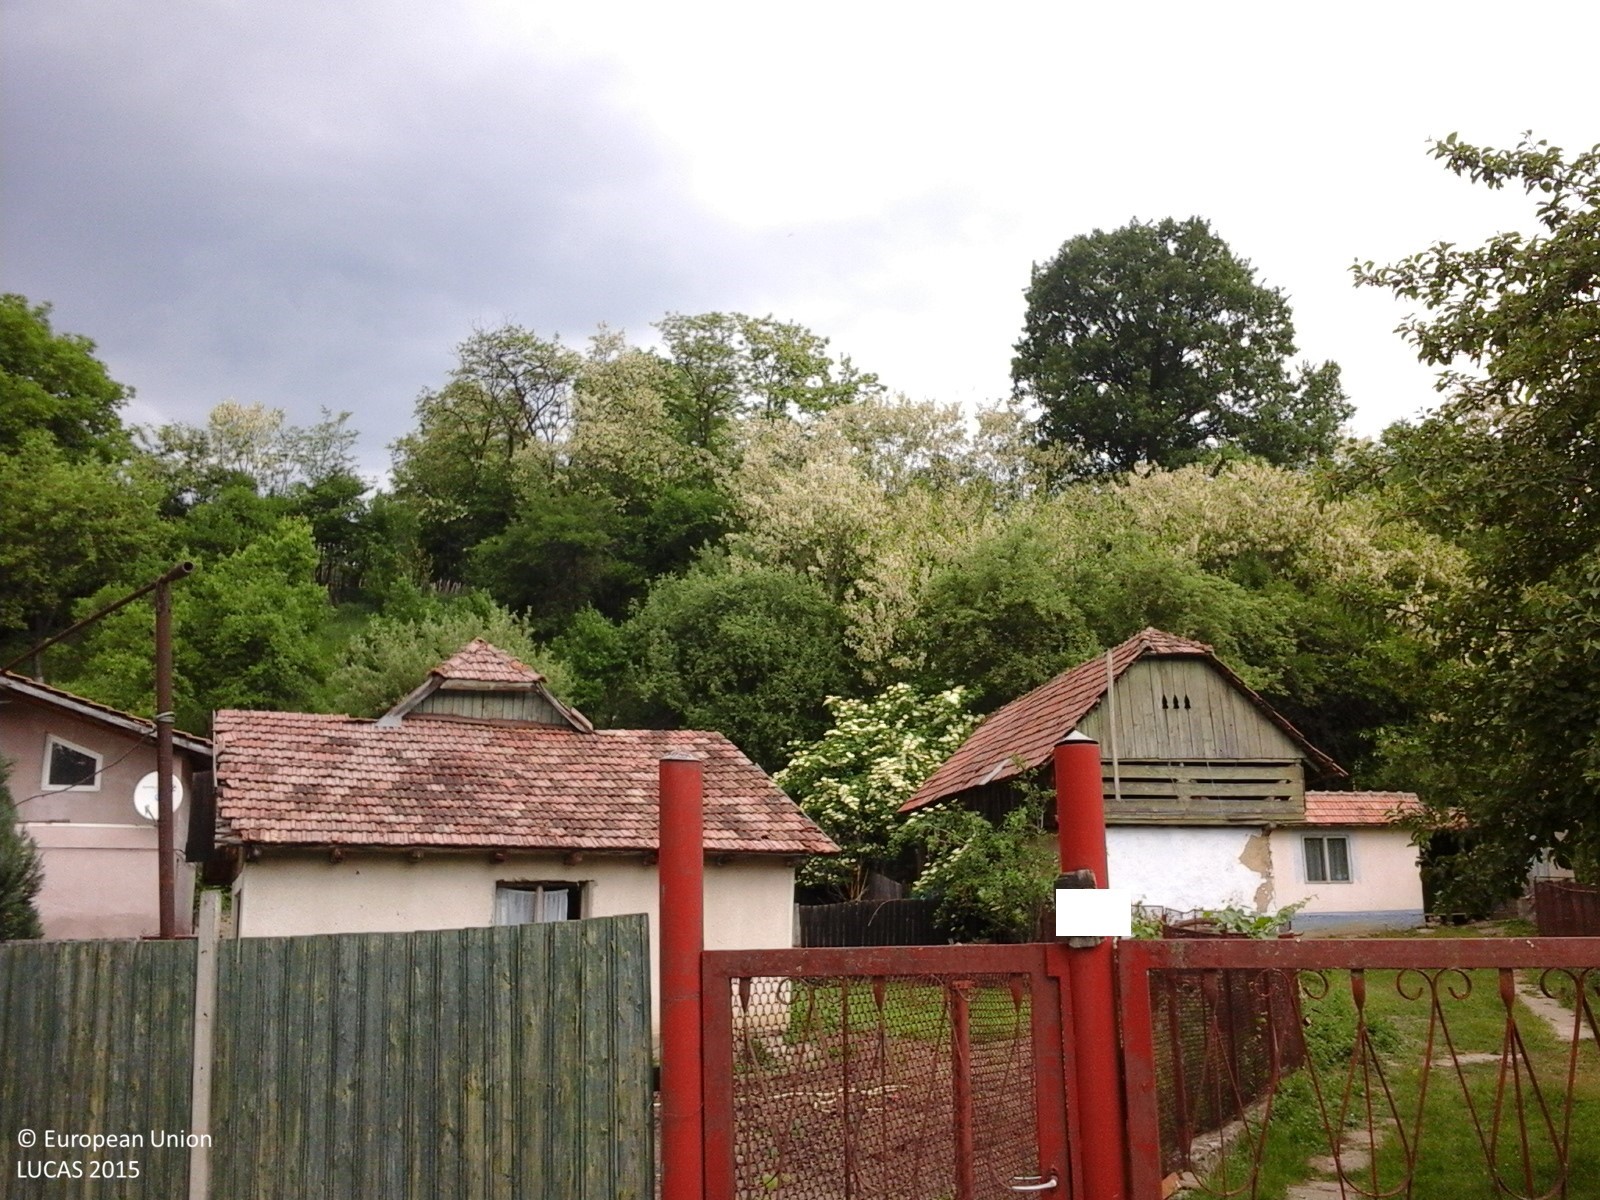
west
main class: Grassland
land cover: Grassland without tree/shrub cover
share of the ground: > 75 %
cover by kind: herbaceous plants 100 %
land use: Residential
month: June
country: RO
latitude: 46.4586
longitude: 26.4736
